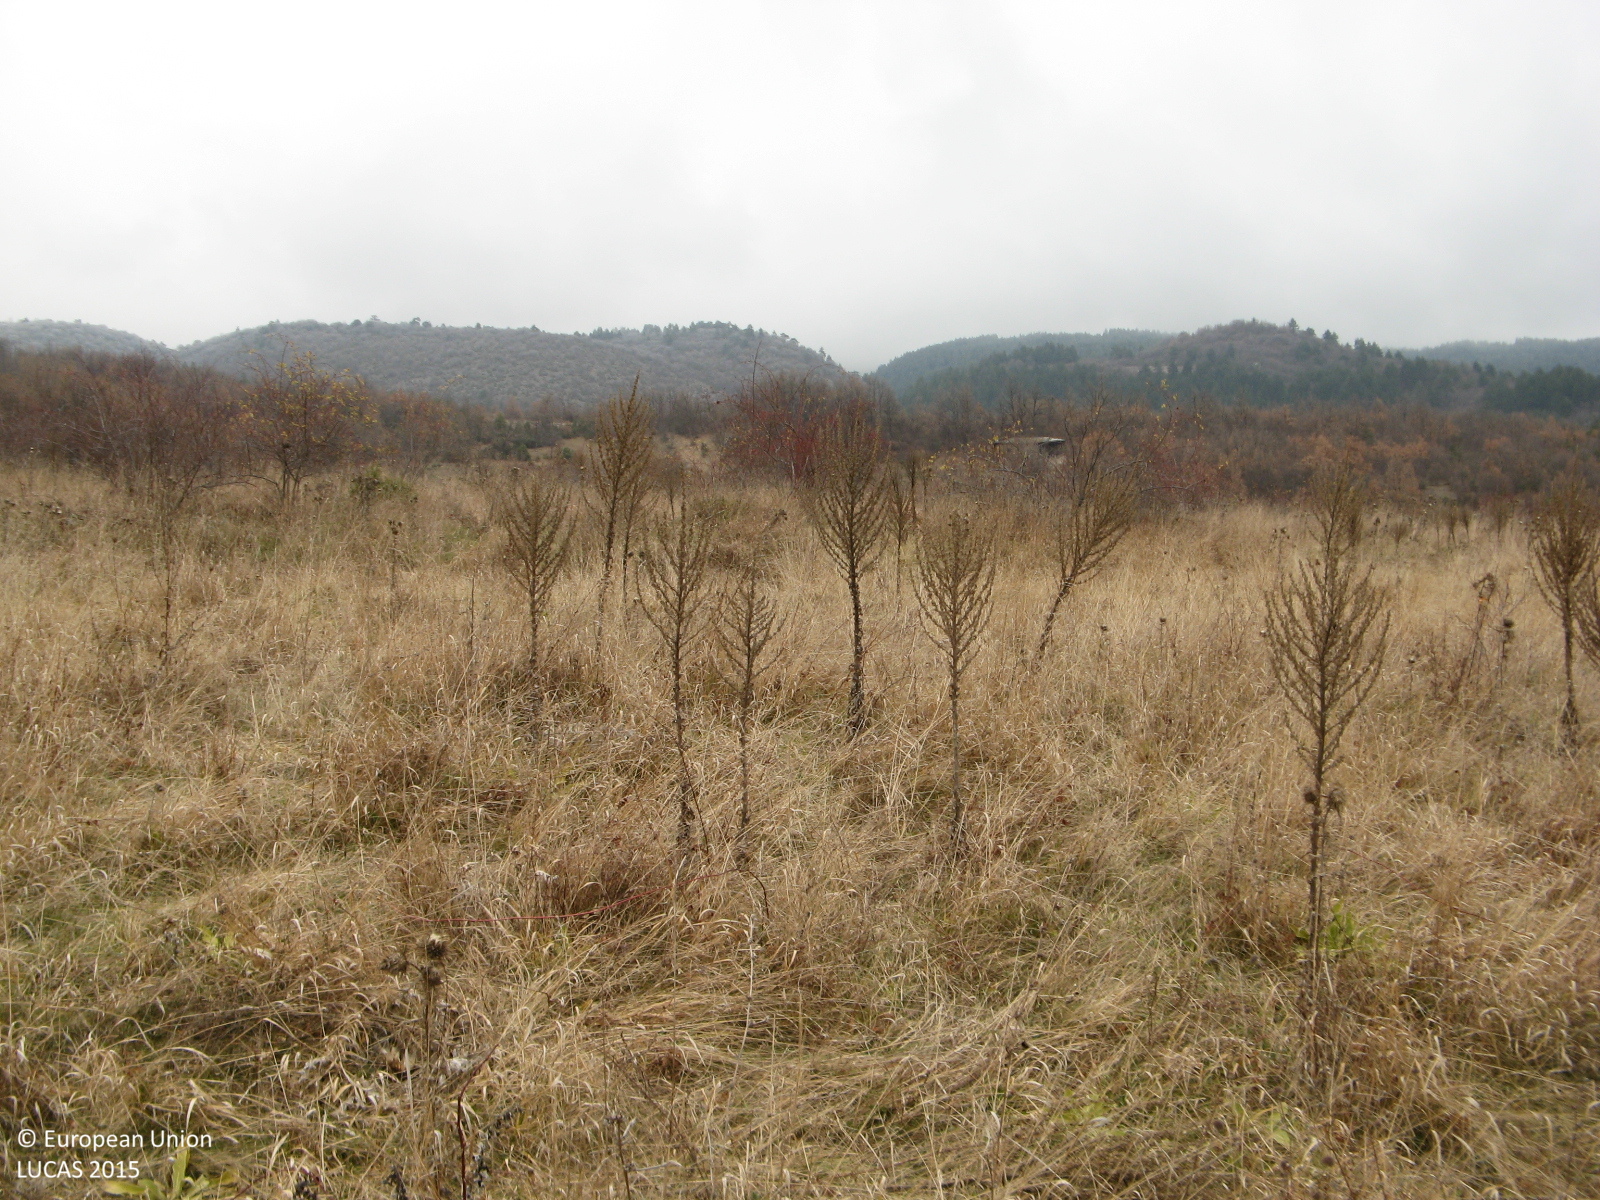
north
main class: Grassland
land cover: Grassland without tree/shrub cover
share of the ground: > 75 %
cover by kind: herbaceous plants 95 %, shrubs 5 %
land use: Agriculture (excluding fallow land and kitchen gardens)
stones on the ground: < 10 %
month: December
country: BG
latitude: 41.8771
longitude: 24.6384
